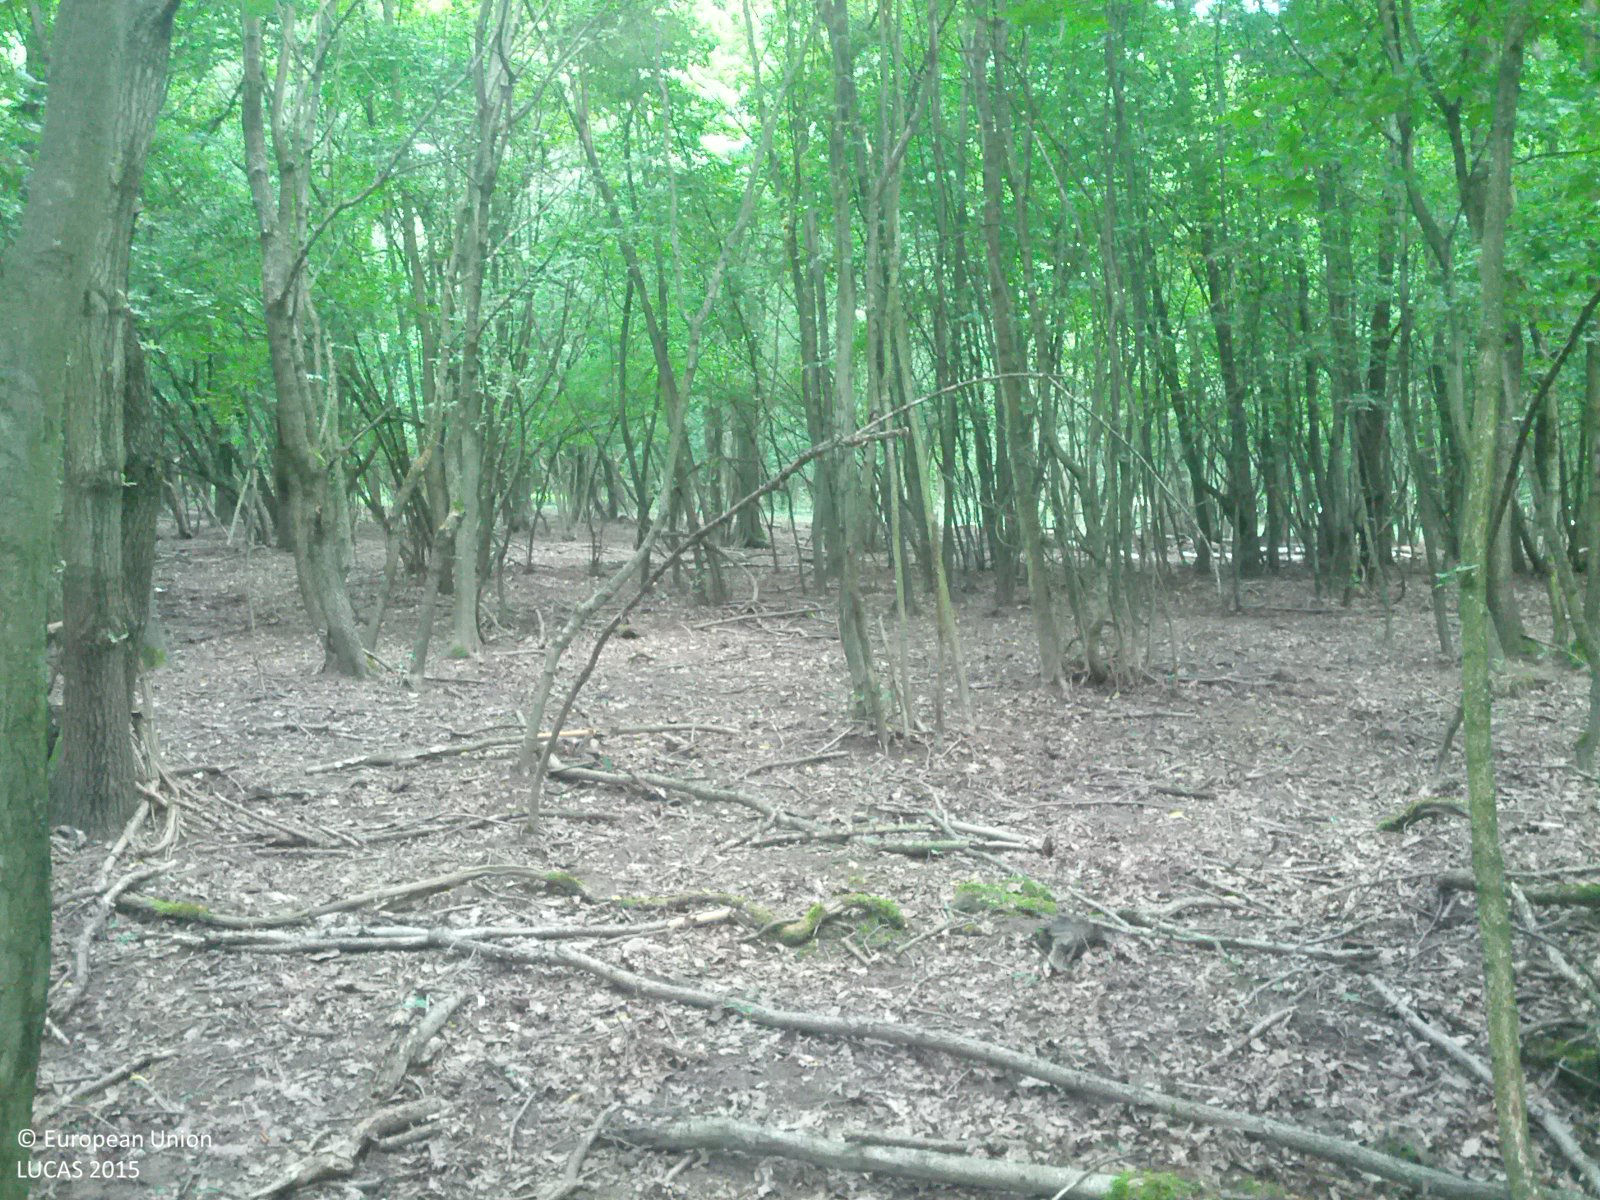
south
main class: Woodland
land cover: Broadleaved woodland
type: beech forest
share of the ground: > 75 %
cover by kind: broadleaved forest trees 95 %, herbaceous plants 5 %
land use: Forestry
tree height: > 5 m
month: June
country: AT
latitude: 48.4334
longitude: 16.7243
